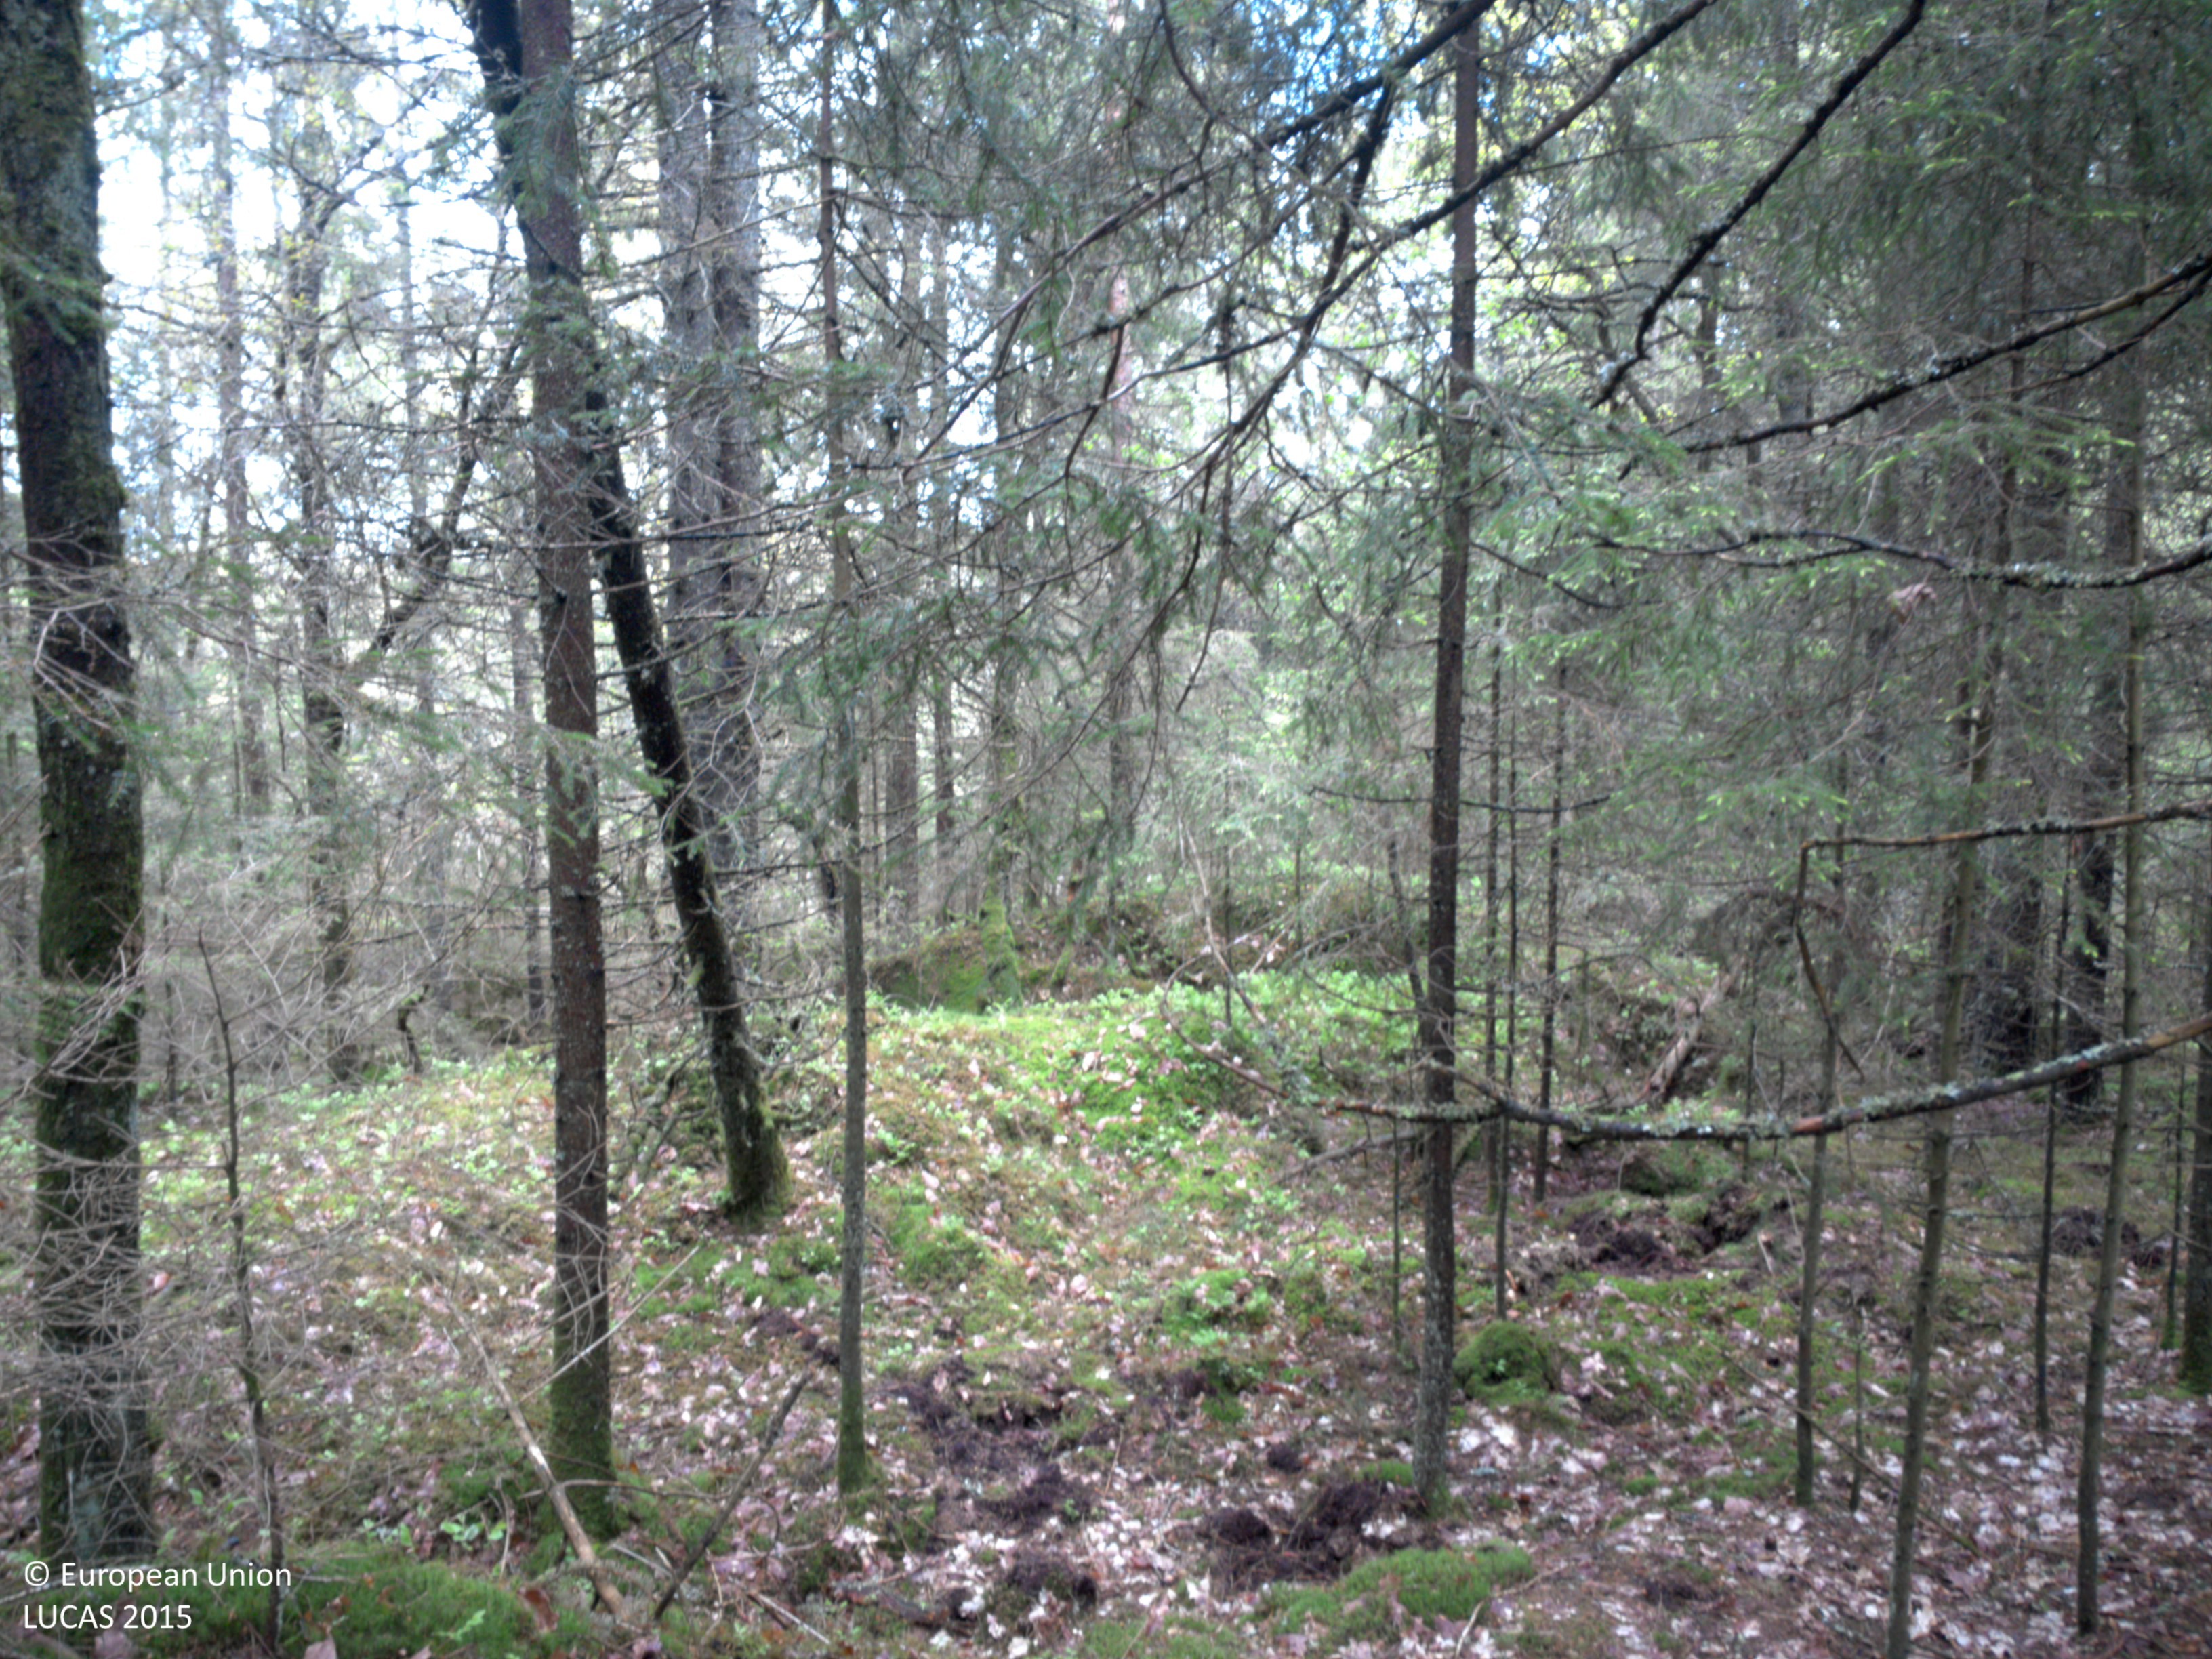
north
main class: Woodland
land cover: Spruce dominated coniferous woodland
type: boreal forest
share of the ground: 50 - 75 %
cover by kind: coniferous forest trees 65 %, herbaceous plants 35 %
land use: Forestry
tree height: > 5 m
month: June
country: SE
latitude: 57.9711
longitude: 11.9744
